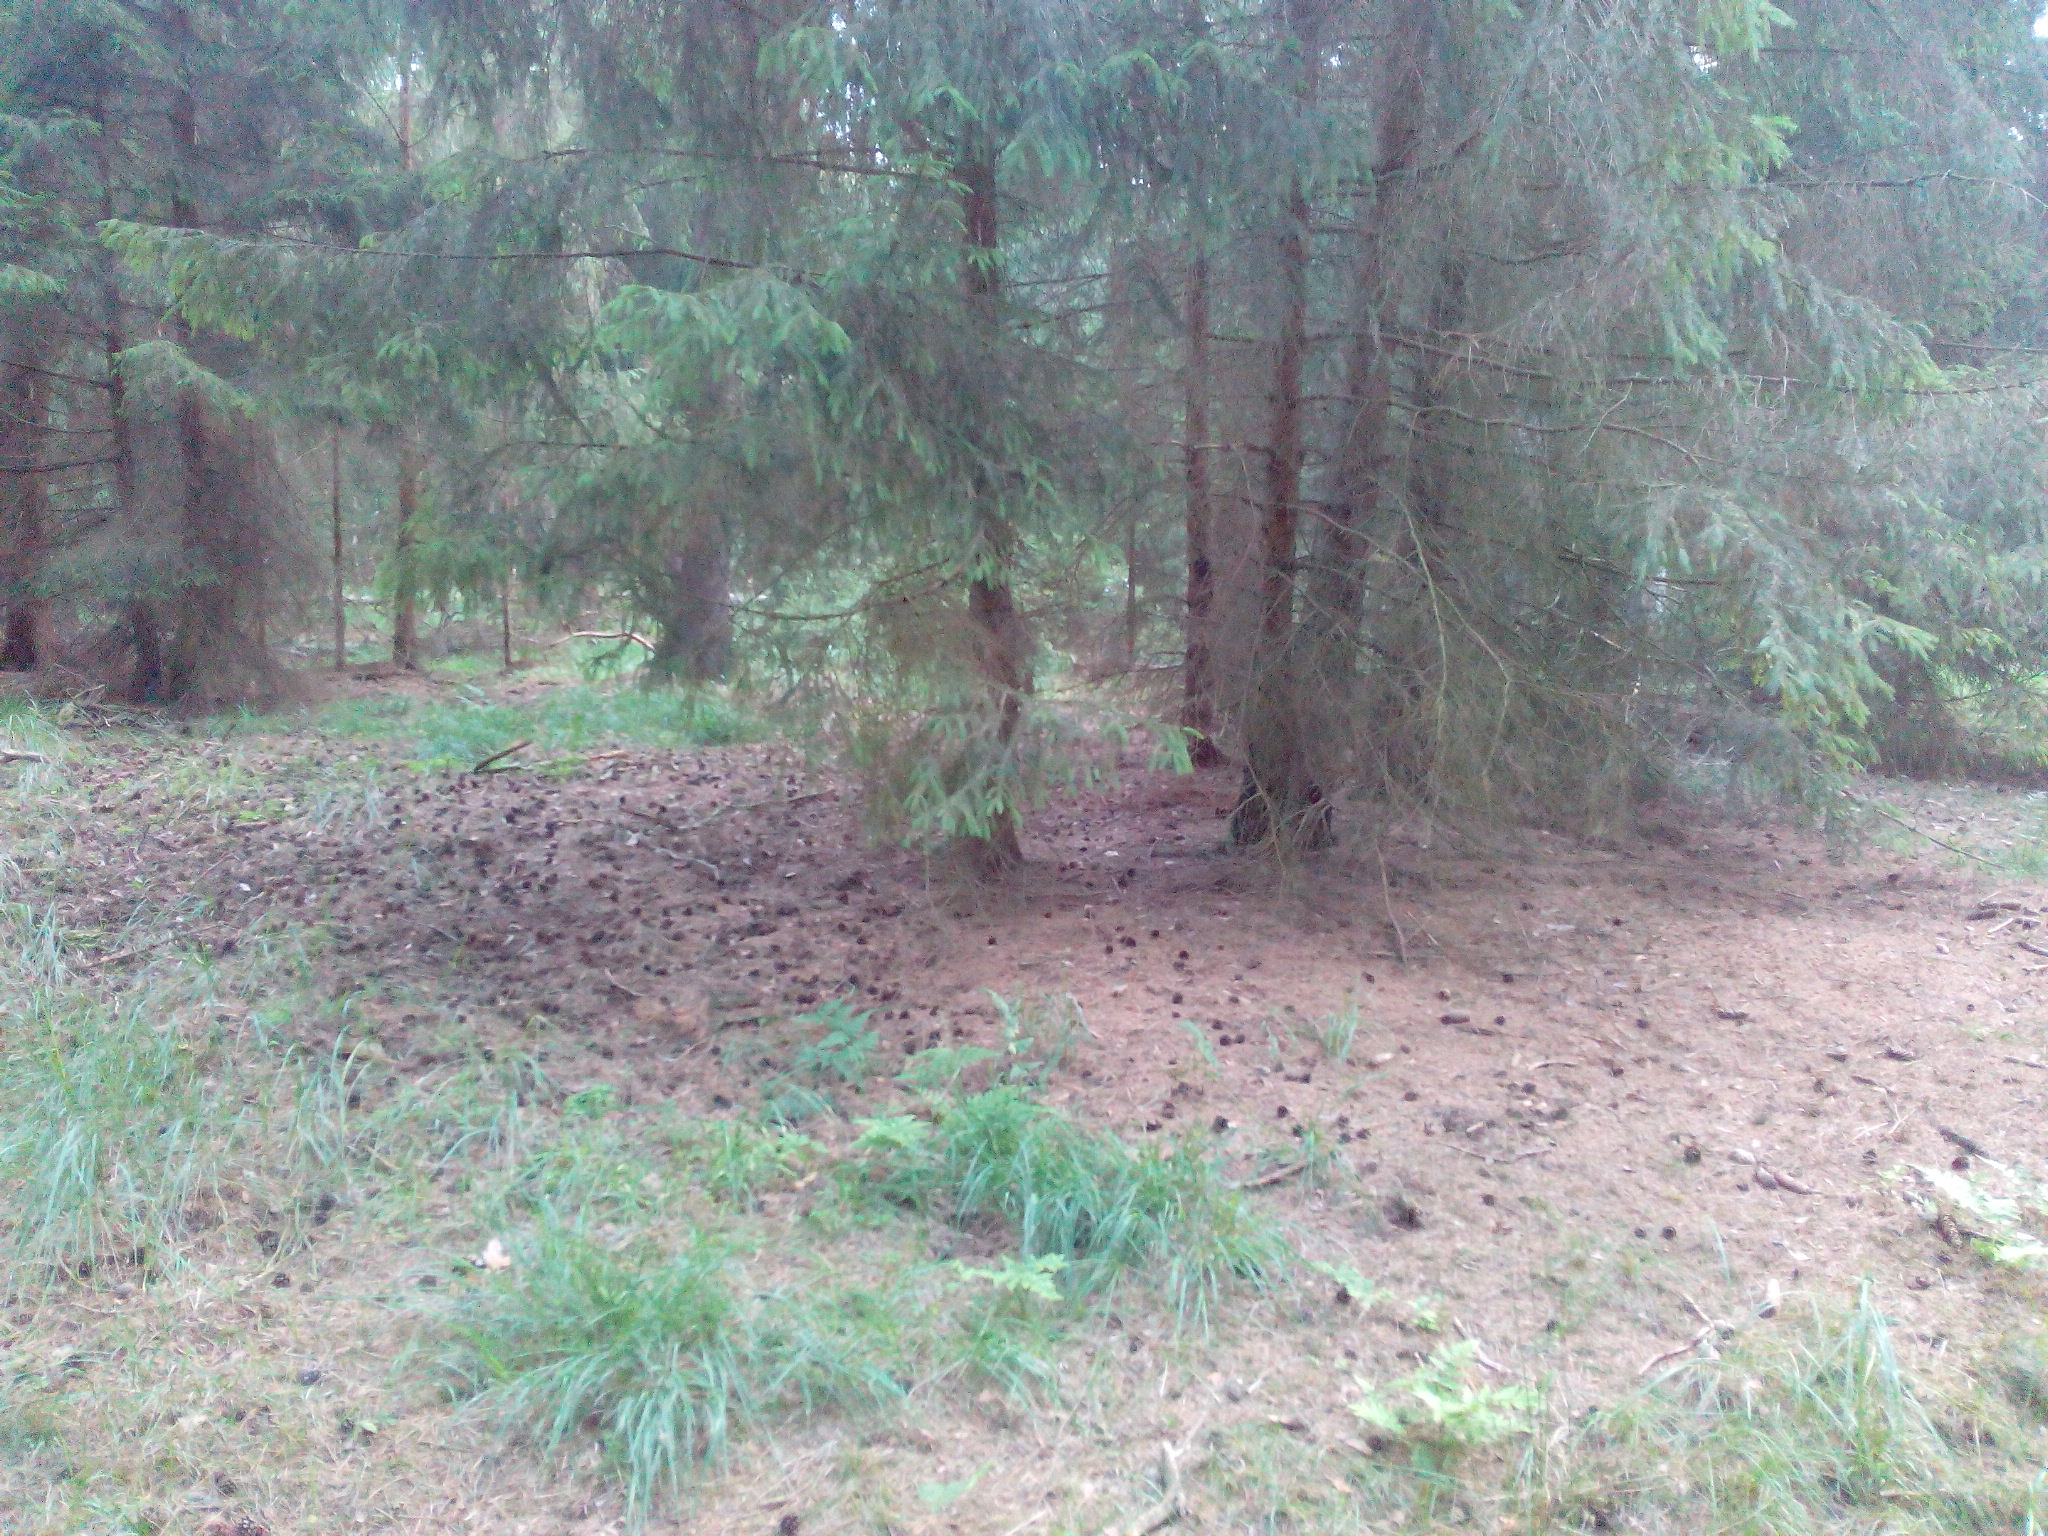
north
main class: Woodland
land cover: Spruce dominated coniferous woodland
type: hemiboreal forest and nemoral coniferous forest and mixed broadleaved-coniferous forest
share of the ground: > 75 %
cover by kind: coniferous forest trees 75 %, herbaceous plants 25 %
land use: Forestry
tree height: > 5 m
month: August
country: DE
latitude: 52.5931
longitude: 9.8967
